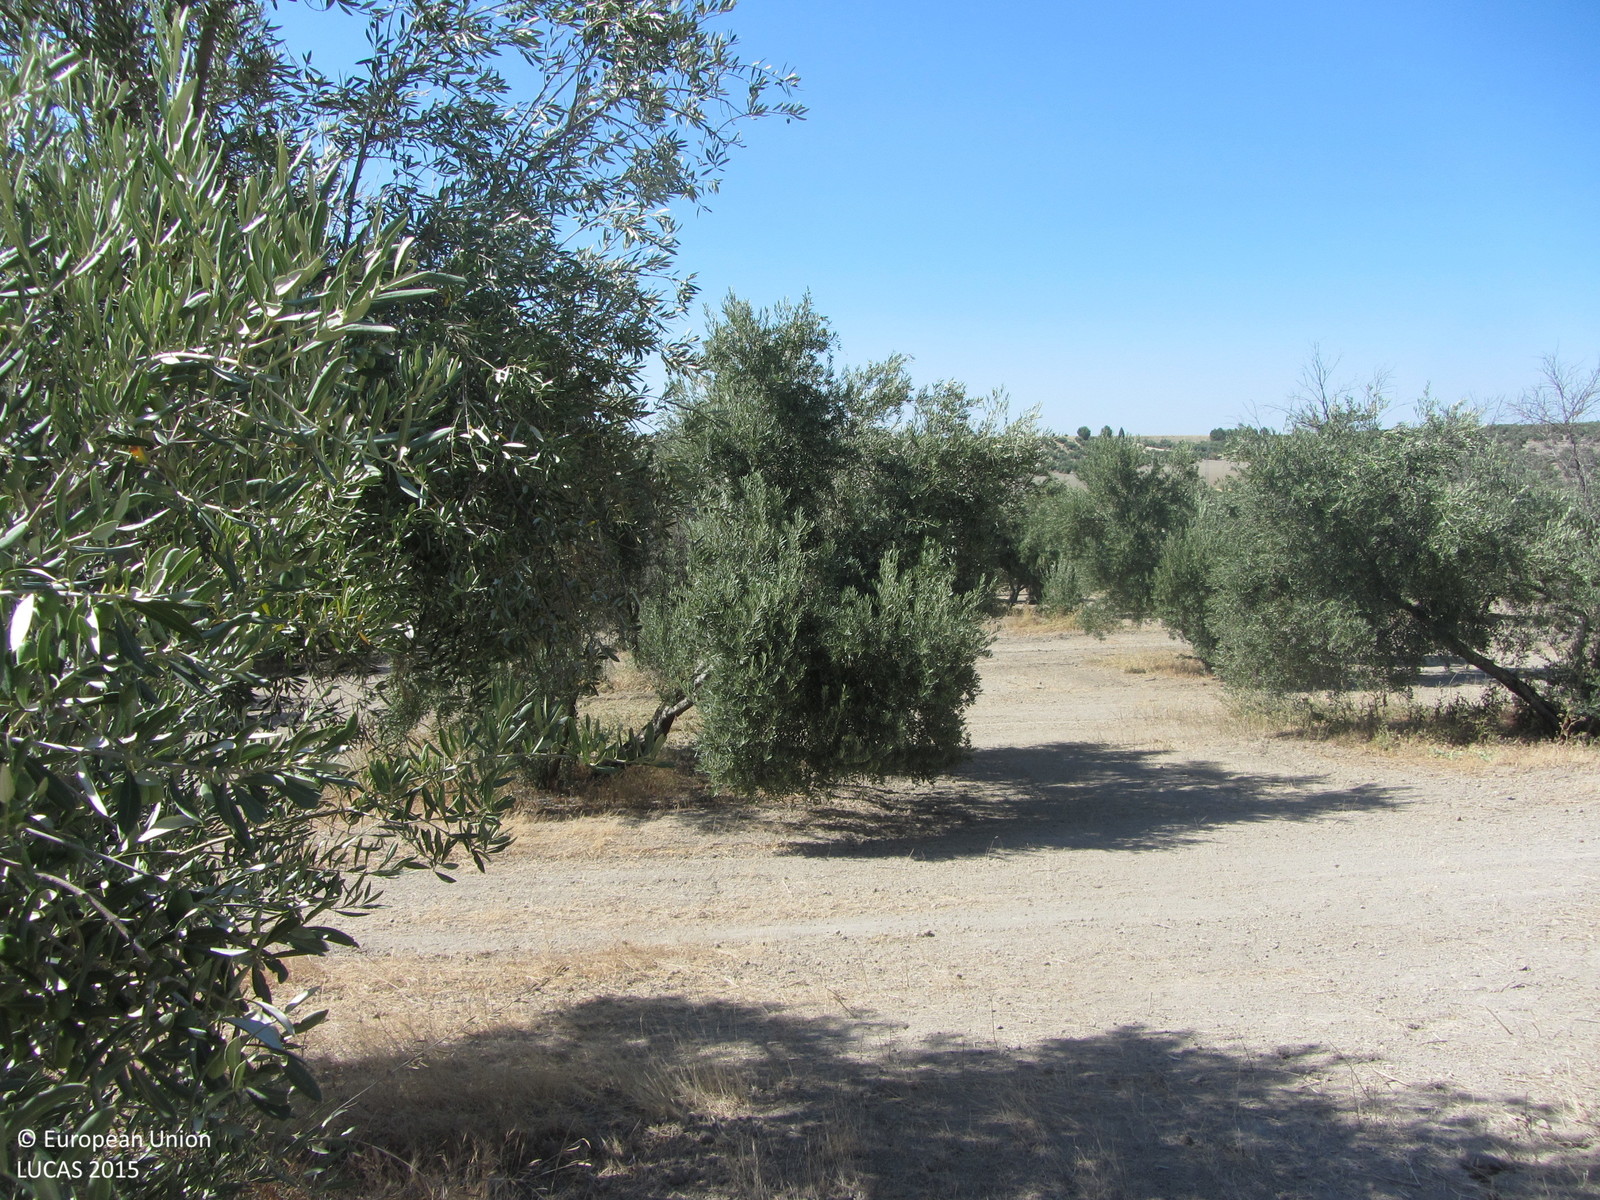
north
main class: Cropland
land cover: Olive groves
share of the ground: 25 - 50 %
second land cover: Other bare soil
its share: > 75 %
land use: Agriculture (excluding fallow land and kitchen gardens)
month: July
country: ES
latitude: 37.9761
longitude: -3.8592
